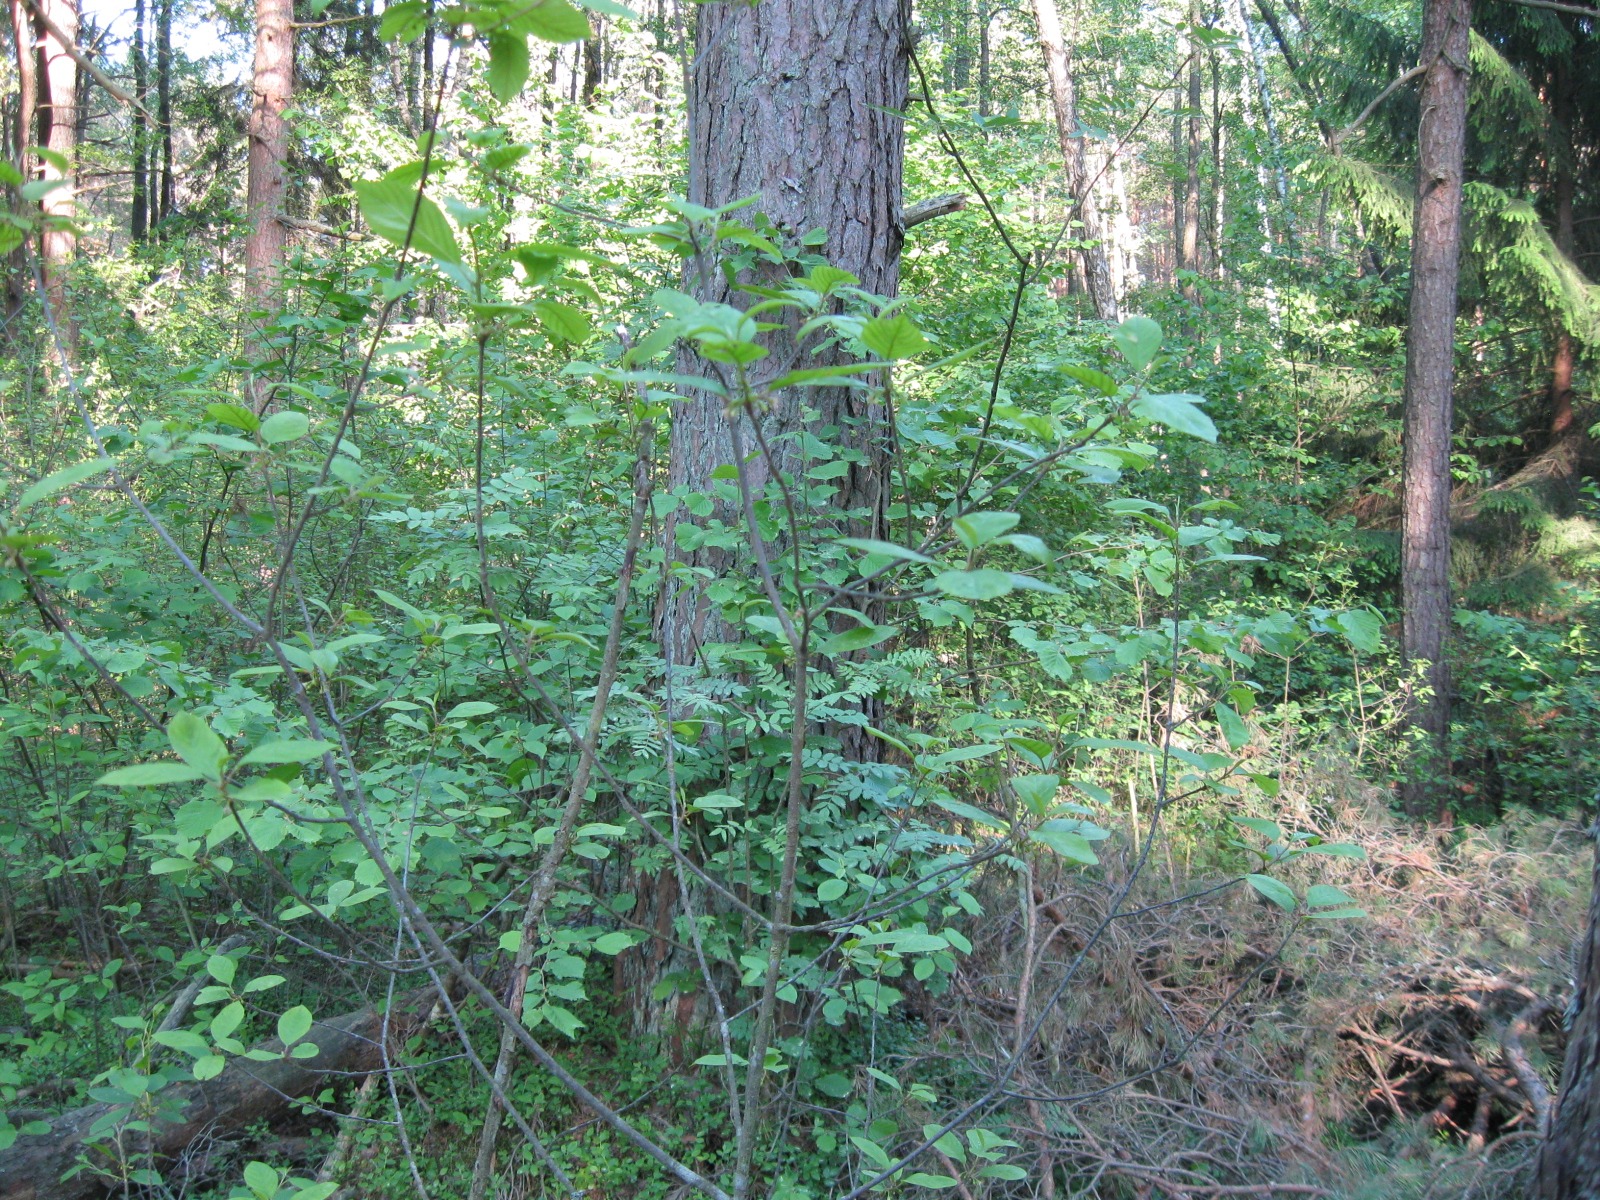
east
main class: Woodland
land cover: Pine dominated mixed woodland
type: hemiboreal forest and nemoral coniferous forest and mixed broadleaved-coniferous forest
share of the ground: > 75 %
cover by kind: coniferous forest trees 60 %, broadleaved forest trees 30 %, herbaceous plants 10 %
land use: Forestry
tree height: > 5 m
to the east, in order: Pine dominated mixed woodland; Other mixed woodland; Broadleaved woodland; Tracks; Pine dominated mixed woodland; Other mixed woodland; Broadleaved woodland; Rivers and streams; Broadleaved woodland; Pine dominated mixed woodland
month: June
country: LT
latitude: 54.1308
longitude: 23.7227
